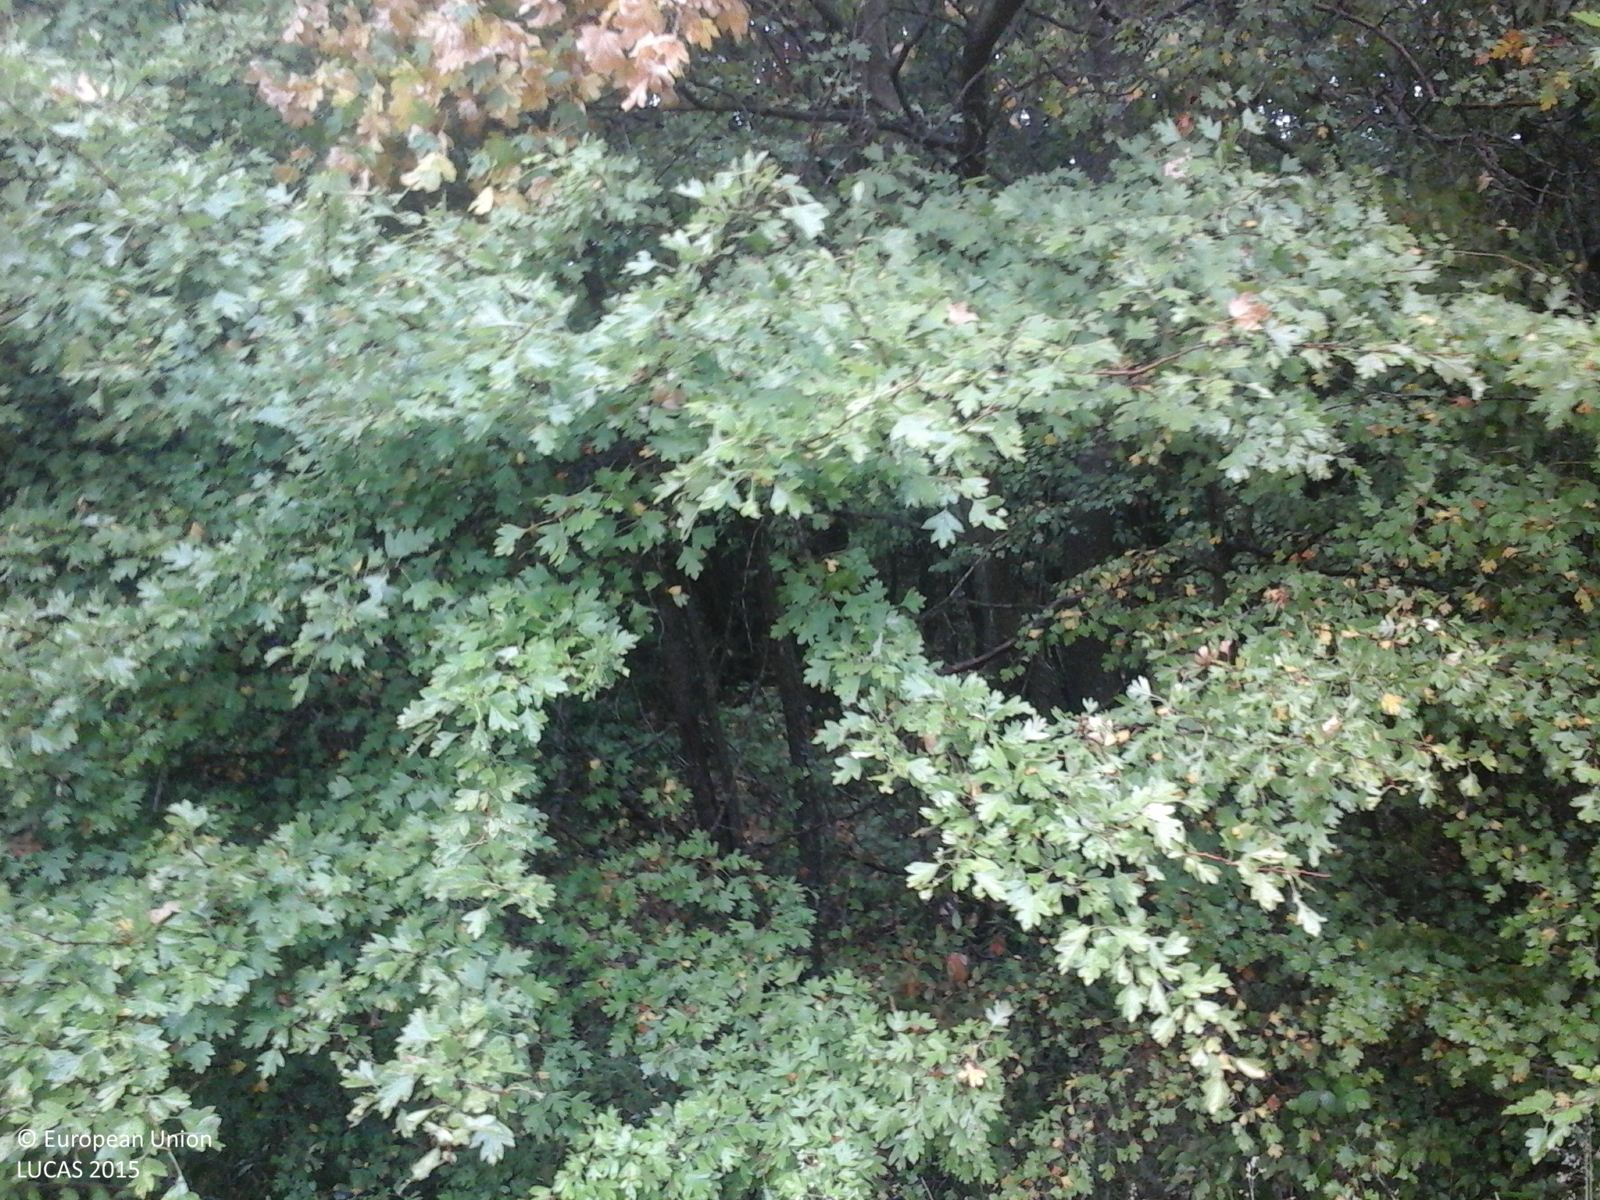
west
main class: Woodland
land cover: Broadleaved woodland
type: thermophilous deciduous forest
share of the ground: > 75 %
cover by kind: broadleaved forest trees 100 %
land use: Forestry
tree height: > 5 m
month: August
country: RO
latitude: 44.5145
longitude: 22.0974
